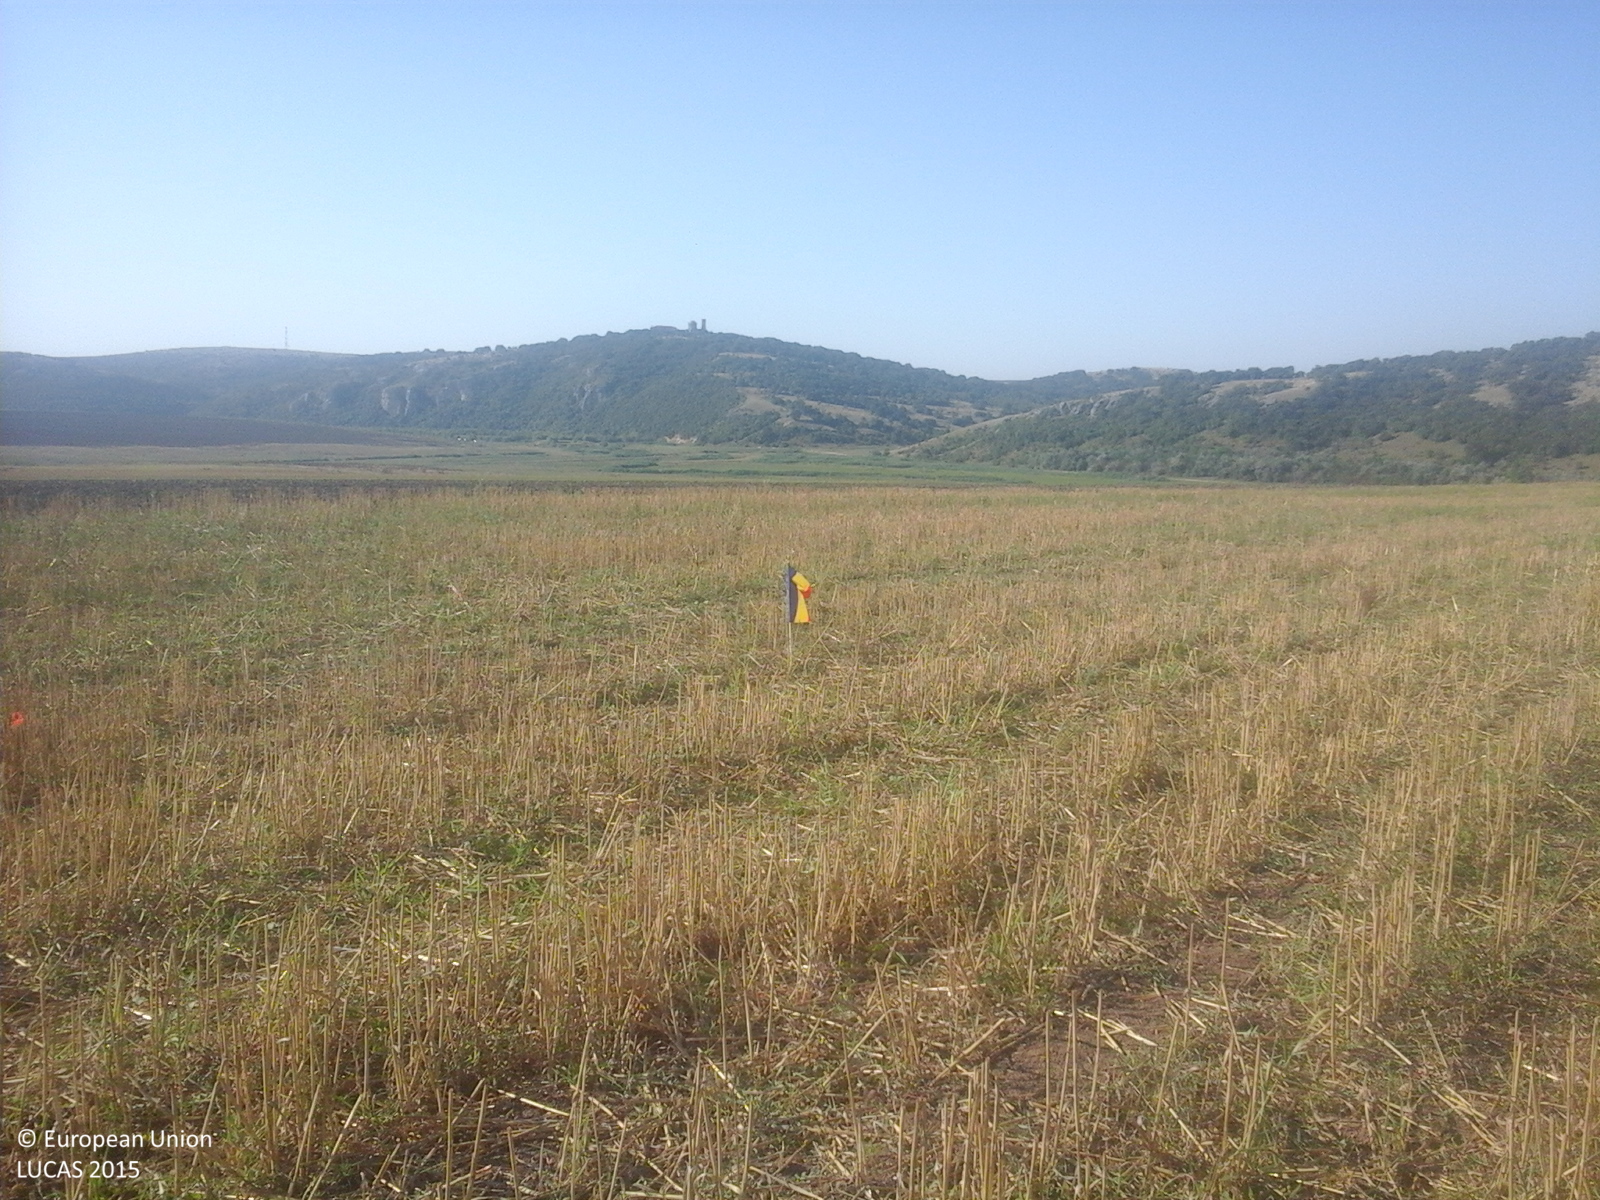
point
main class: Cropland
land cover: Common wheat
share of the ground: > 75 %
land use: Agriculture (excluding fallow land and kitchen gardens)
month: August
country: RO
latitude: 44.5067
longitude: 28.4486
